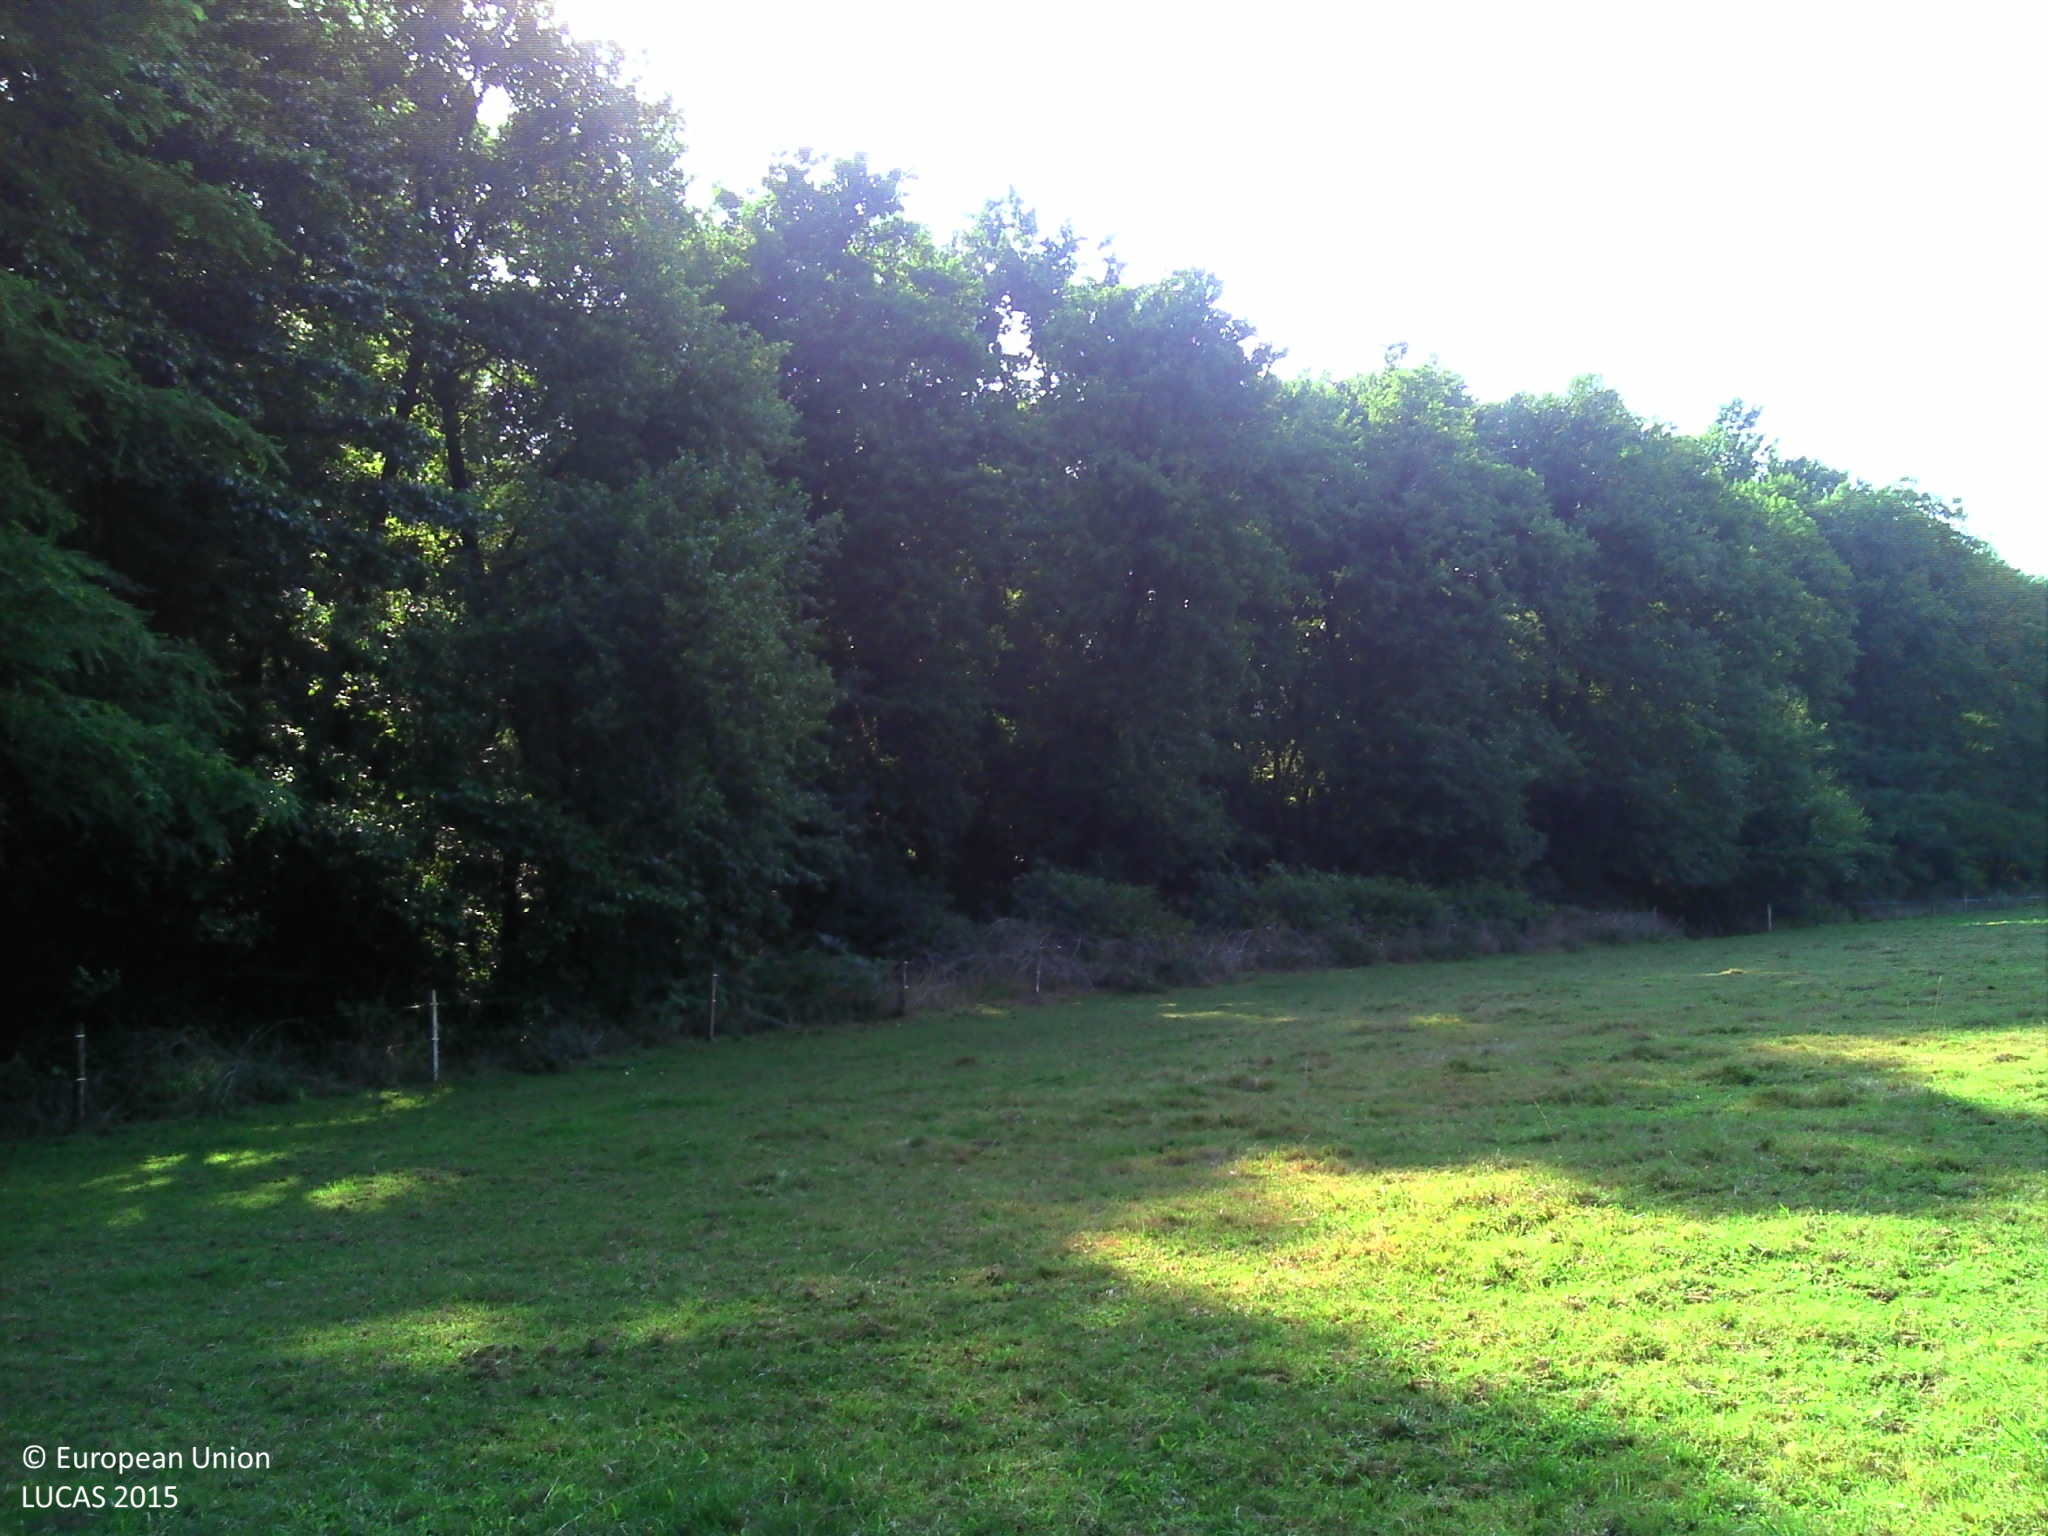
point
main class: Woodland
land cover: Broadleaved woodland
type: mesophytic deciduous forest
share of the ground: > 75 %
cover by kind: broadleaved forest trees 85 %, herbaceous plants 15 %
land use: Forestry
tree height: > 5 m
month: August
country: FR
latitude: 43.7483
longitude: -0.8053
